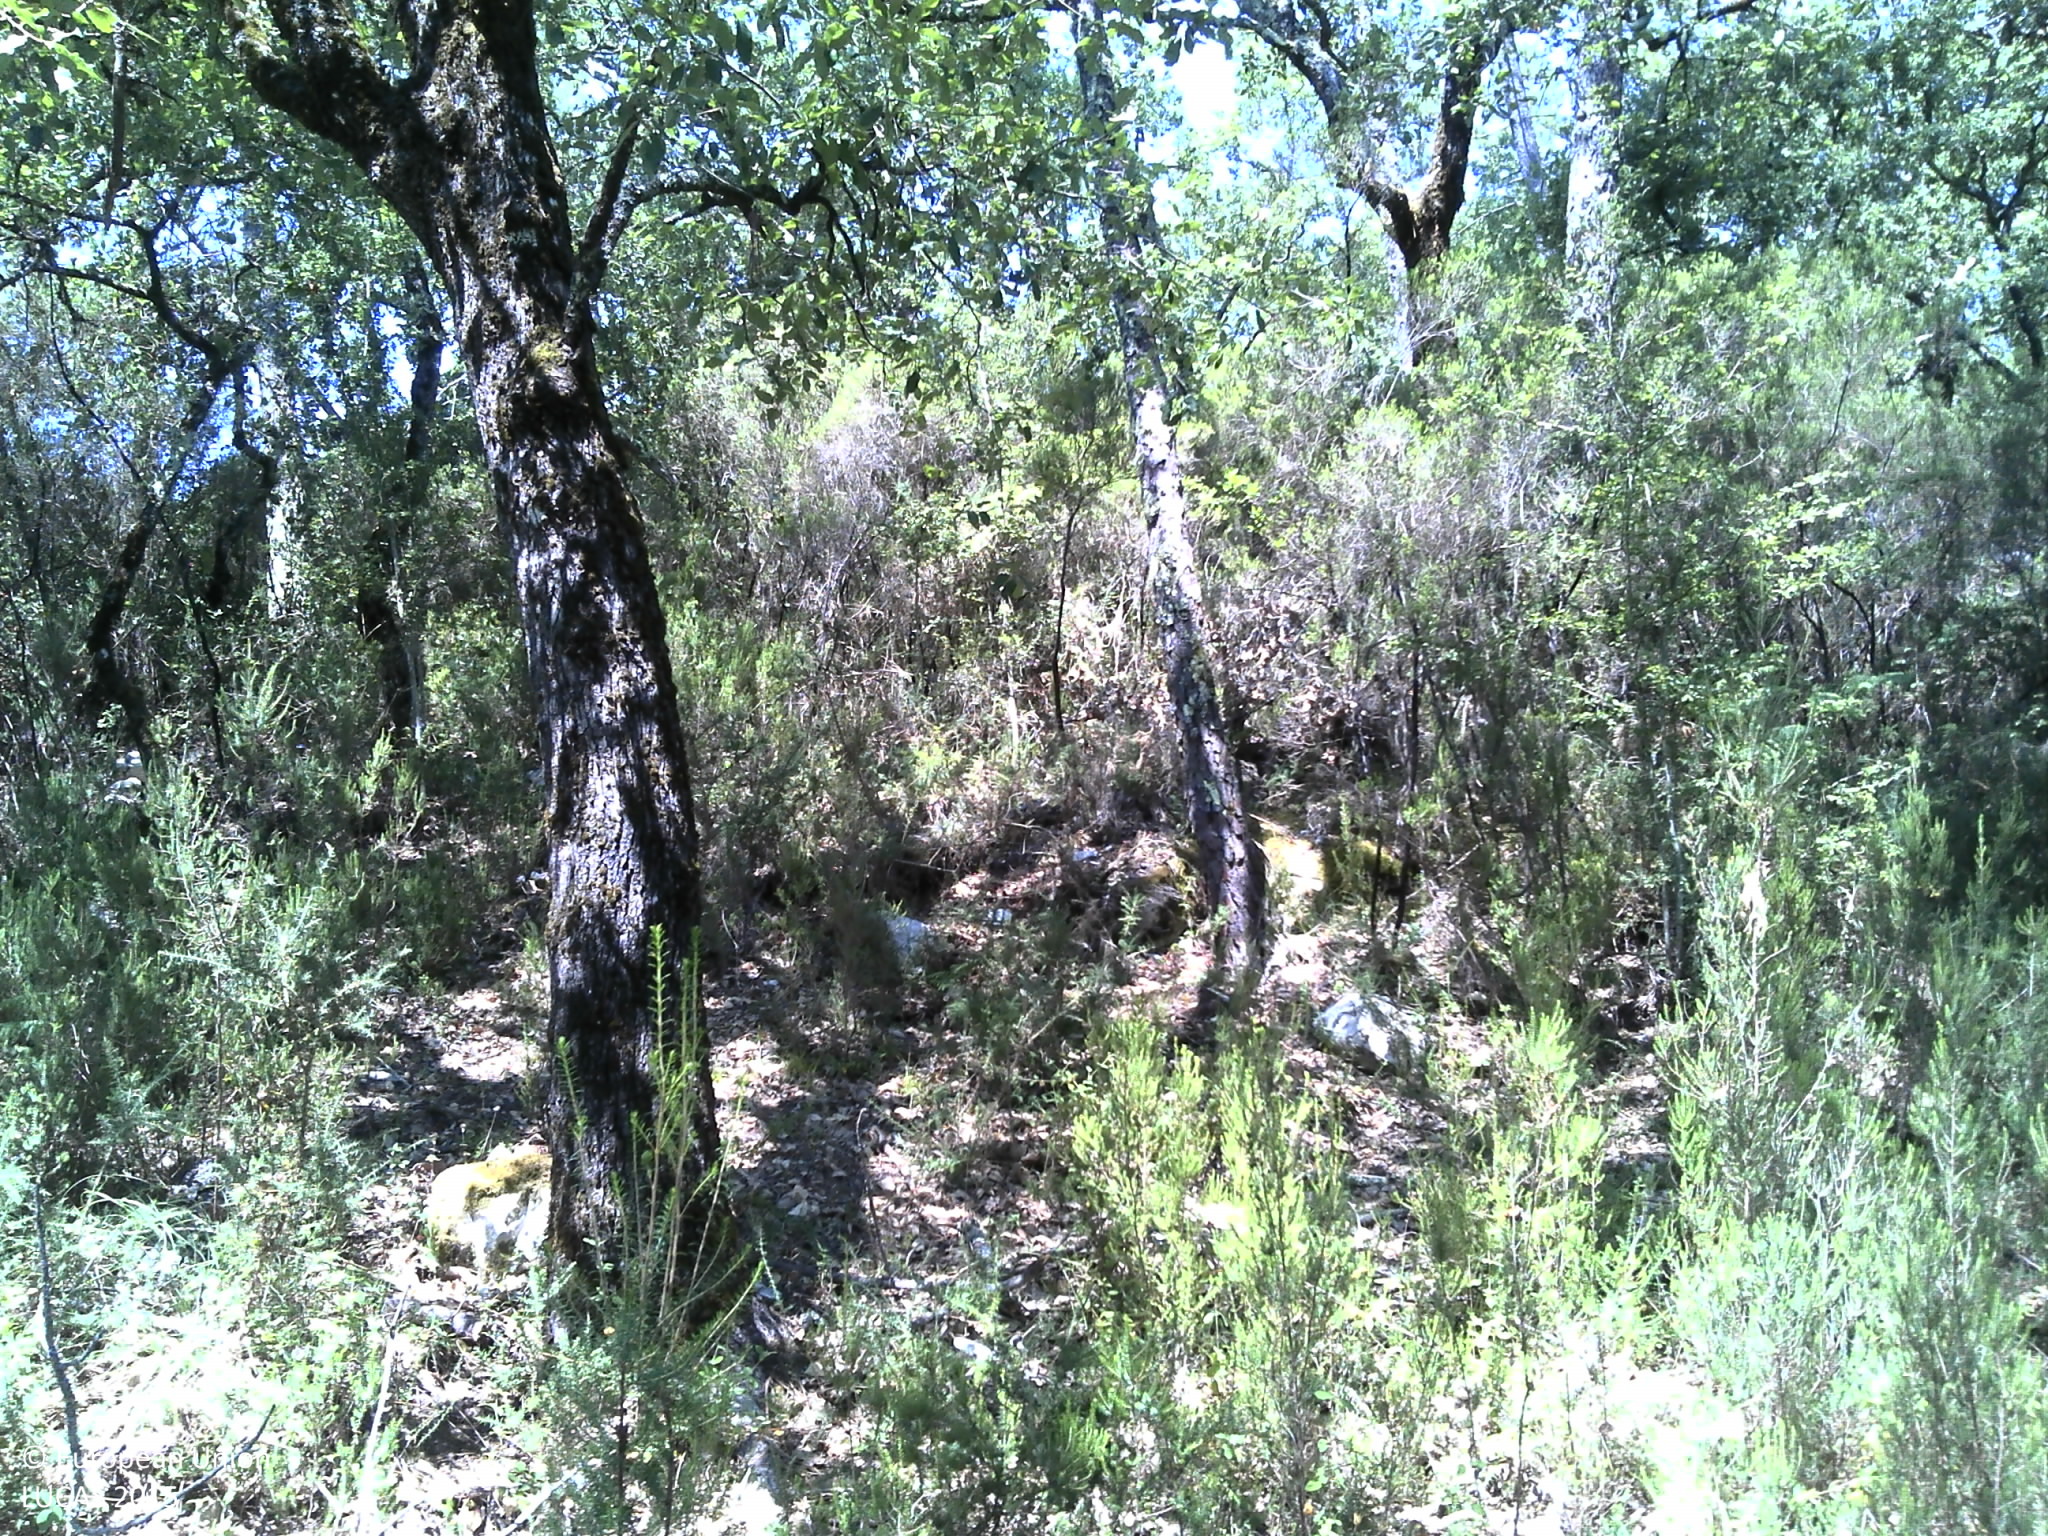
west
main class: Woodland
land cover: Broadleaved woodland
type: thermophilous deciduous forest
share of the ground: 25 - 50 %
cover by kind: broadleaved forest trees 50 %, shrubs 30 %, unconsolidated bare surface 20 %
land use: Forestry
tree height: > 5 m
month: July
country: PT
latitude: 39.9928
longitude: -8.4808
